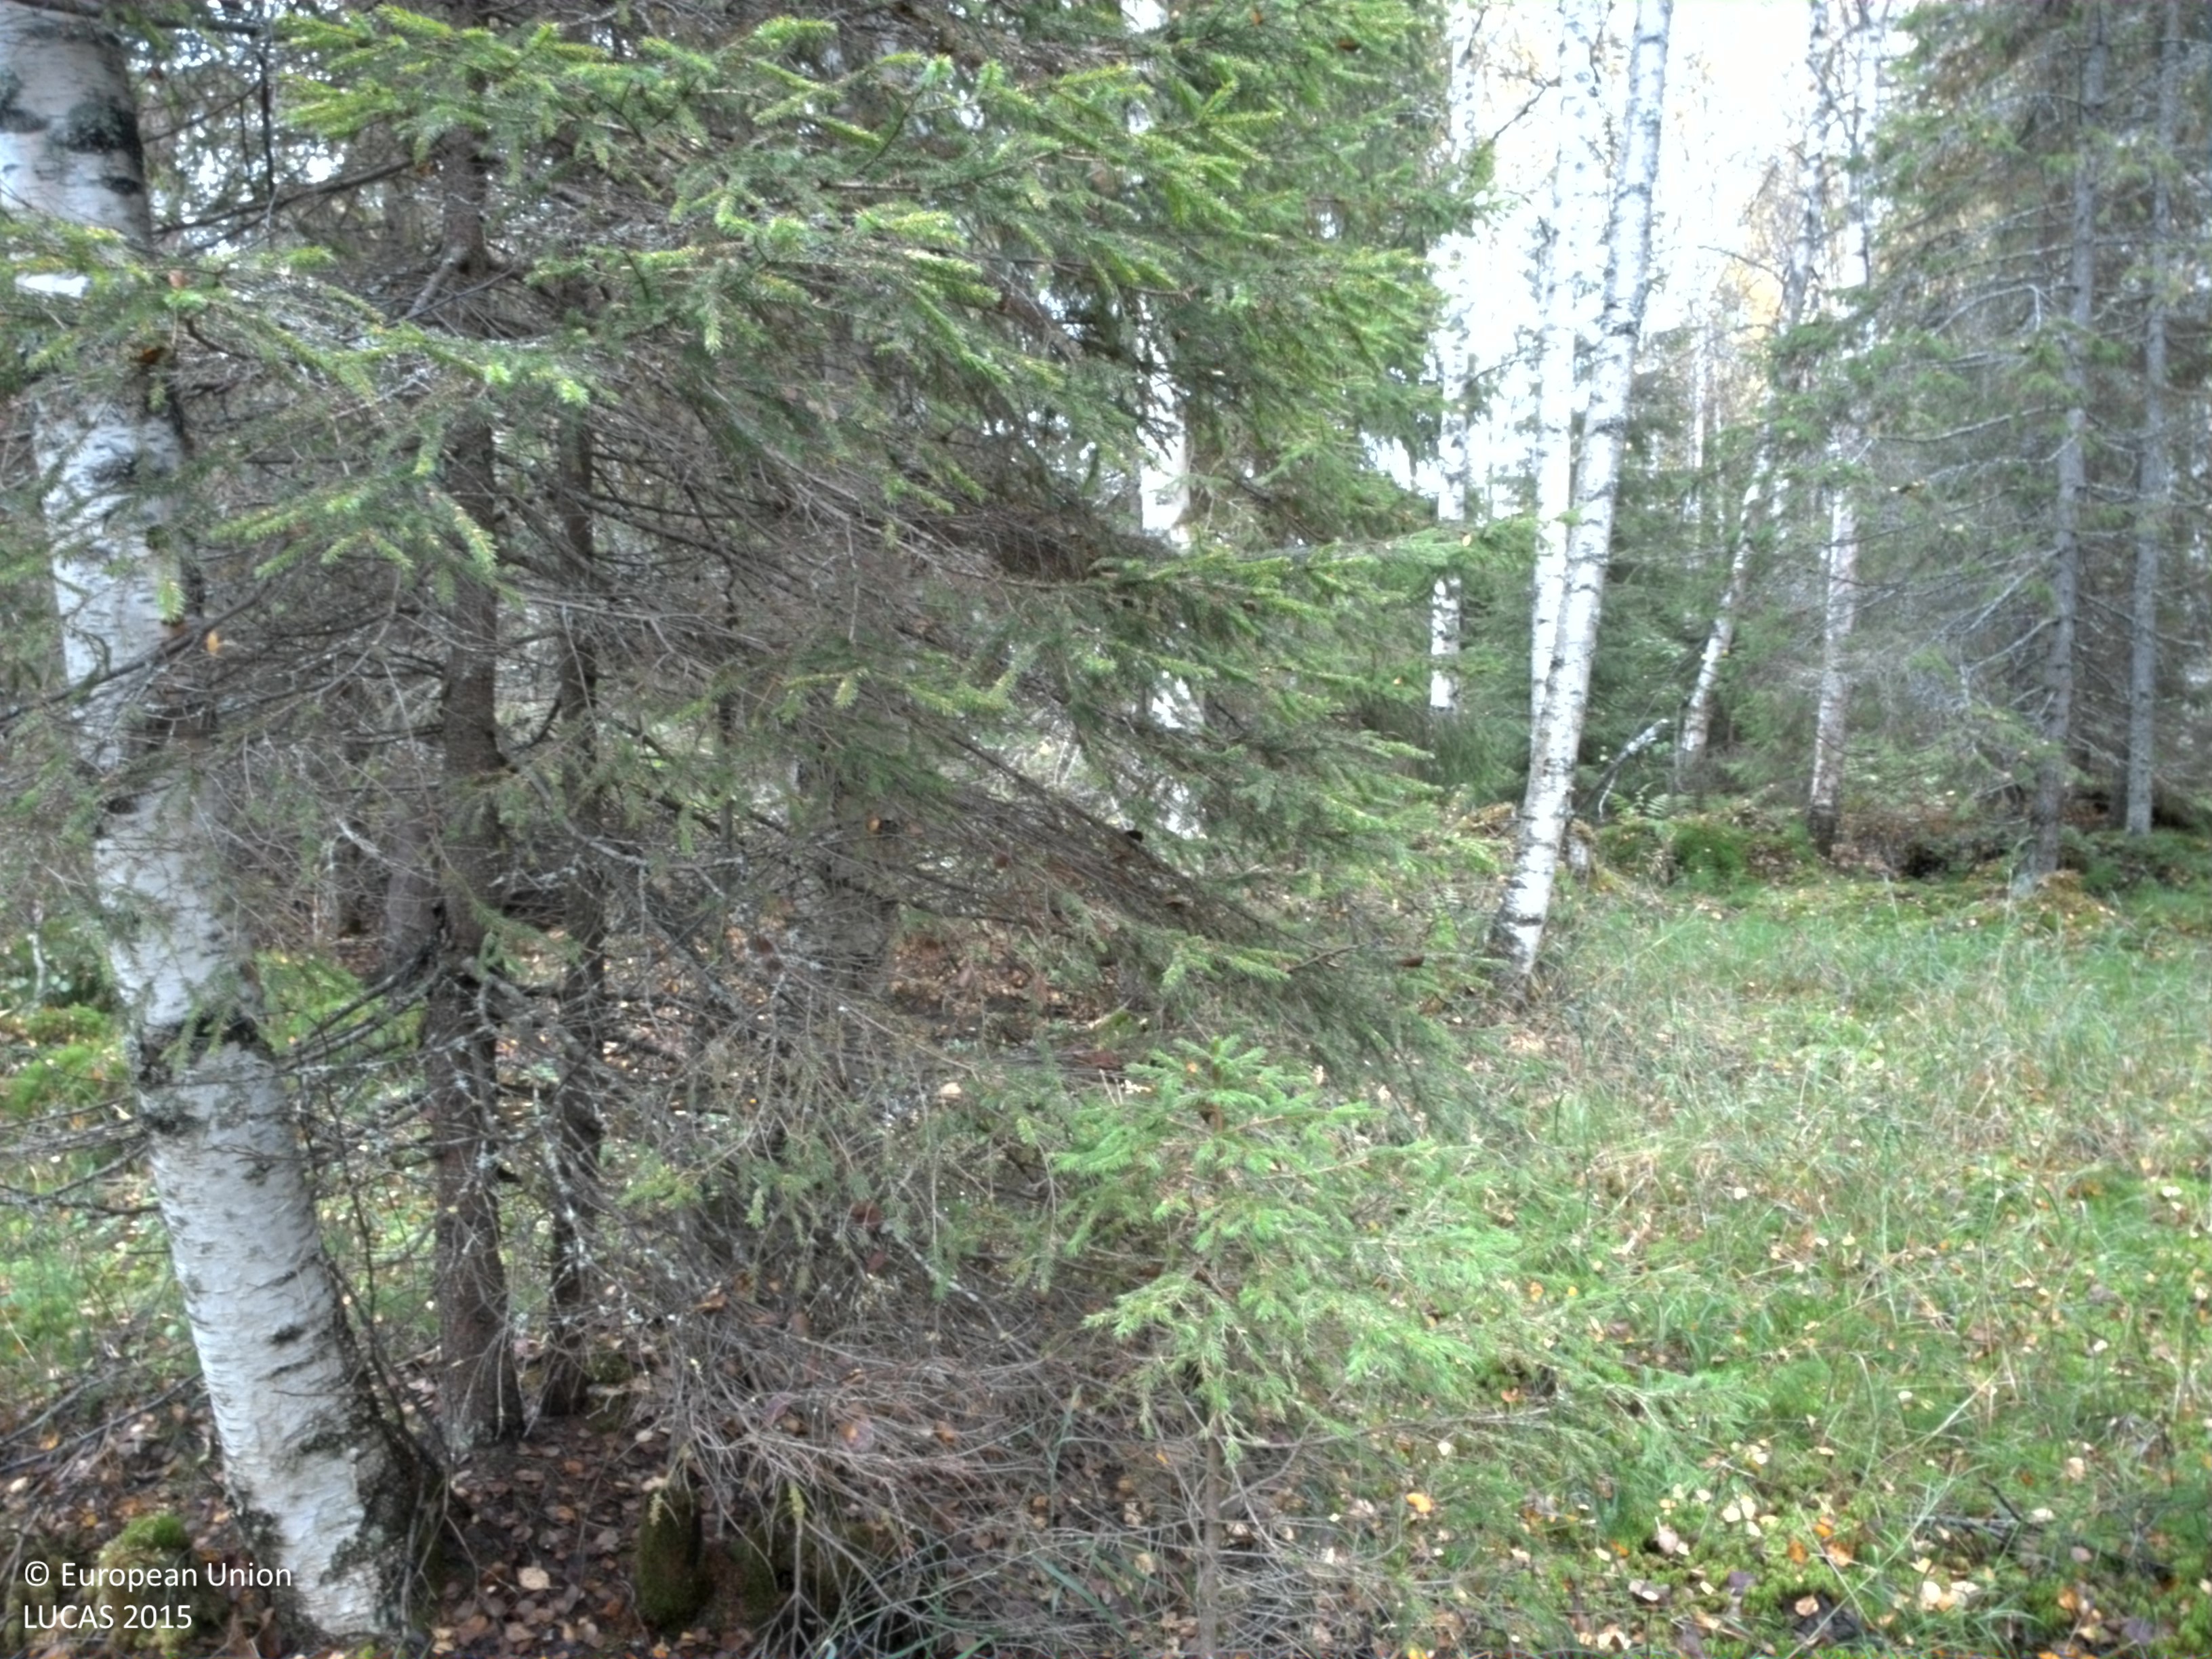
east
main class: Woodland
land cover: Spruce dominated mixed woodland
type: mire and swamp forests
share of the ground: 25 - 50 %
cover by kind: coniferous forest trees 25 %, lichens and mosses 25 %, broadleaved forest trees 20 %, shrubs 15 %, herbaceous plants 15 %
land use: Forestry
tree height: > 5 m
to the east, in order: Spruce dominated mixed woodland; Ditches and canals; Spruce dominated mixed woodland; Spruce dominated coniferous woodland; Grassland with sparse tree/shrub cover; Spruce dominated coniferous woodland; Spruce dominated mixed woodland; Grassland without tree/shrub cover; Electric lines; Grassland without tree/shrub cover; Broadleaved woodland; Spruce dominated mixed woodland; Ditches and canals; Paved roads, cycling and walking lanes; Spruce dominated coniferous woodland; Spruce dominated mixed woodland; Pine dominated mixed woodland
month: September
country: SE
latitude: 65.6413
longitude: 22.3007
